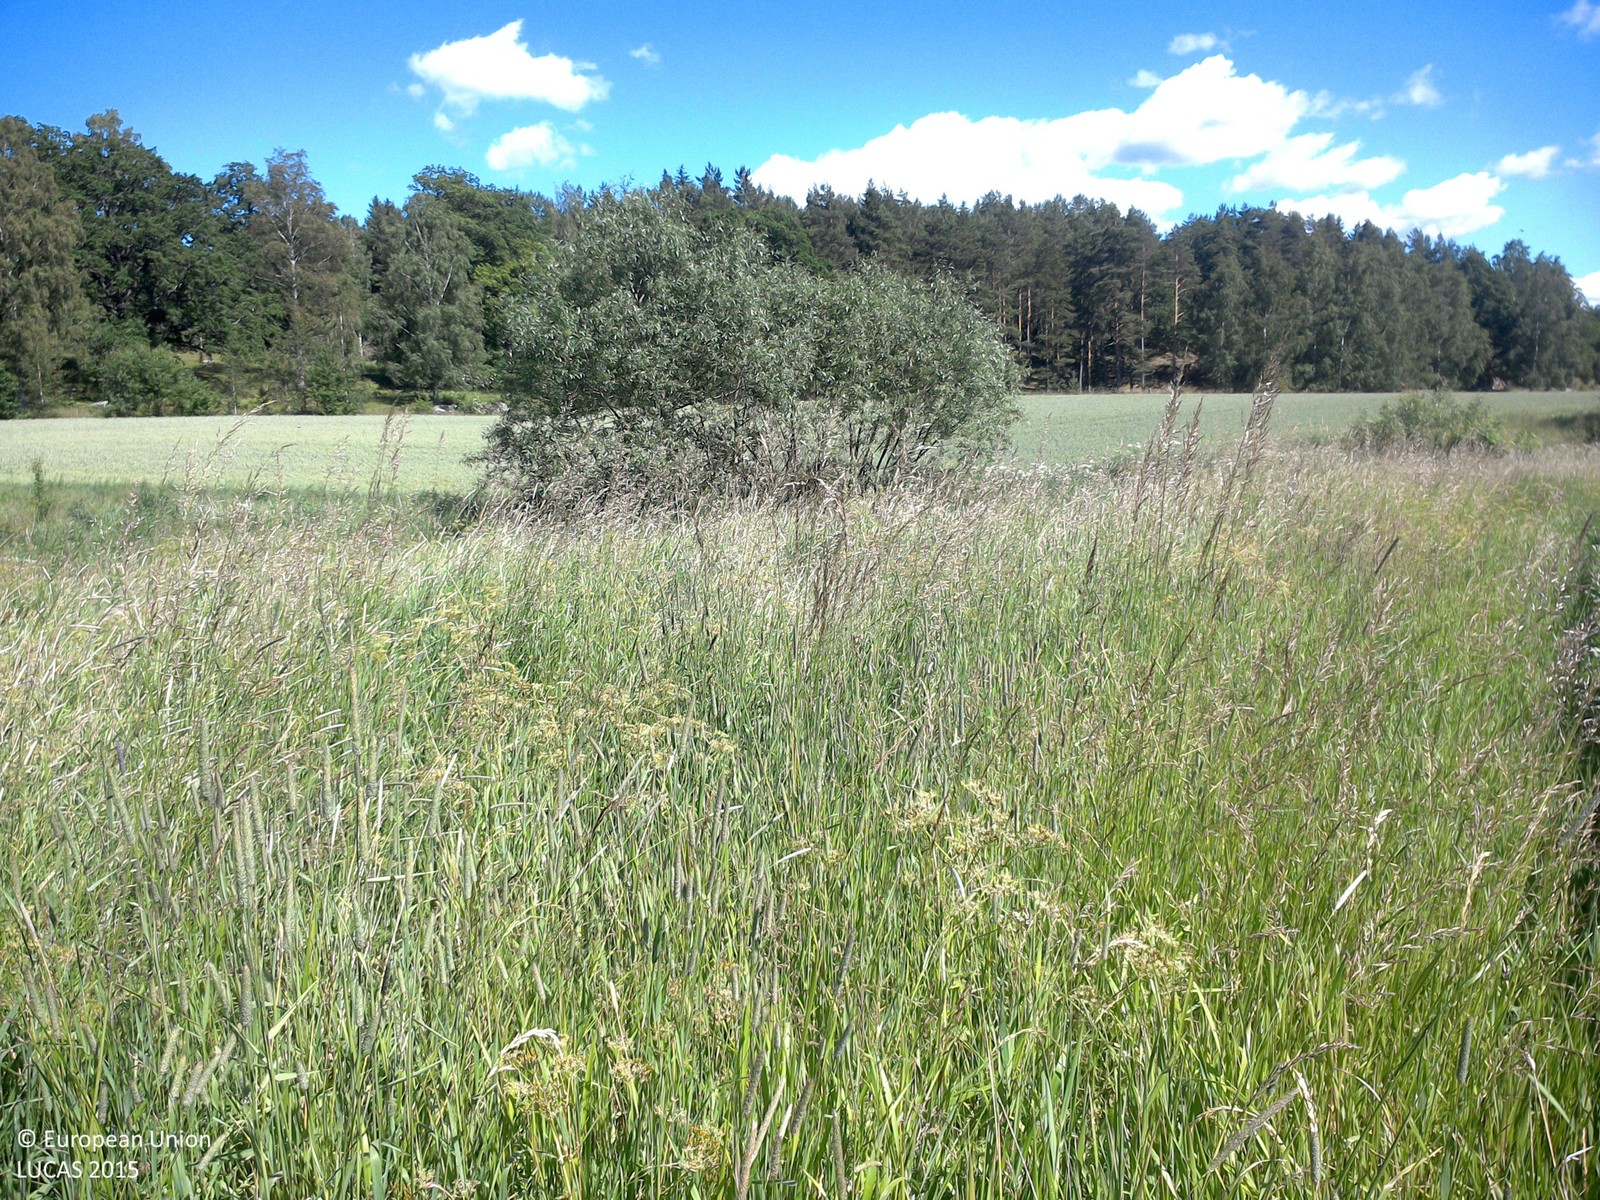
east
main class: Cropland
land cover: Dry pulses
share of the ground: > 75 %
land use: Agriculture (excluding fallow land and kitchen gardens)
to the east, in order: Dry pulses; Grassland with sparse tree/shrub cover; Rivers and streams; Grassland without tree/shrub cover; Common wheat; Grass margins; Fences; Grassland with sparse tree/shrub cover; Pine dominated coniferous woodland
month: July
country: SE
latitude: 58.3092
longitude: 15.4047
